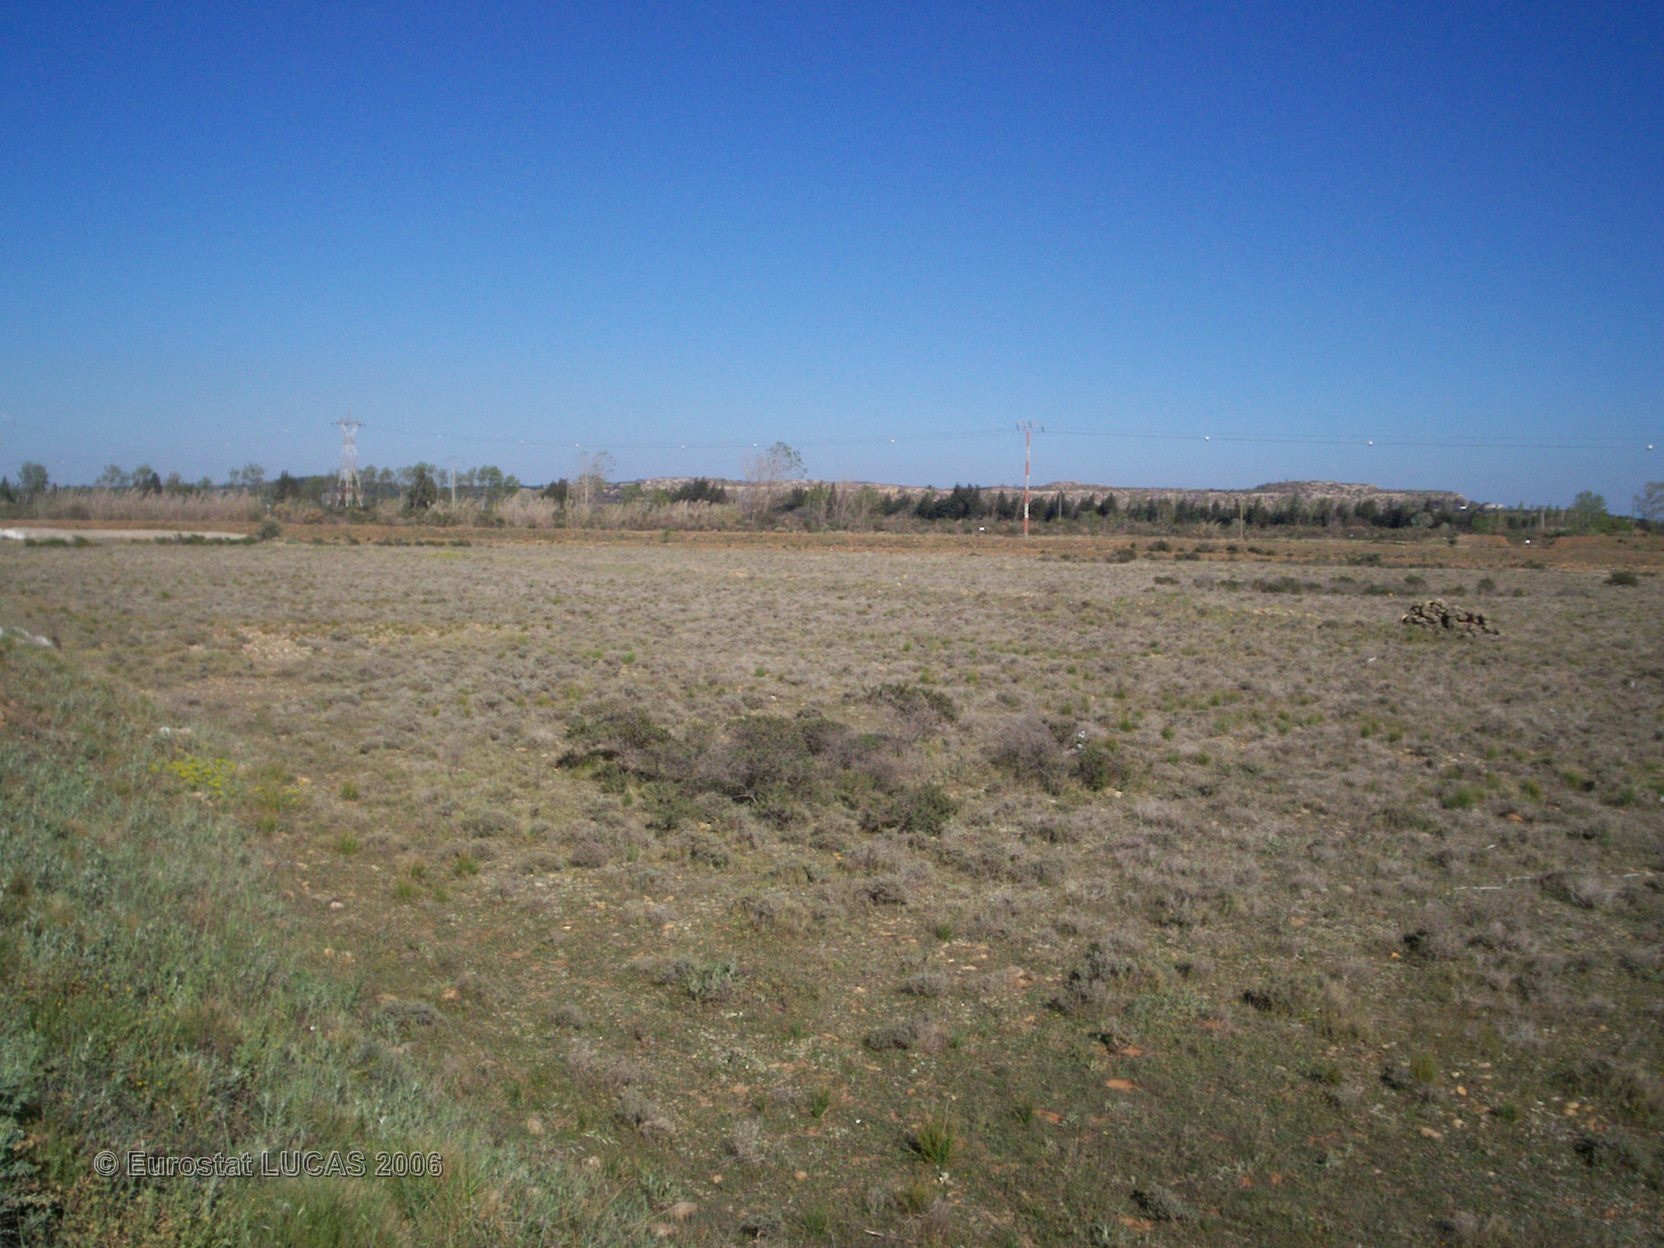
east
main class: Artificial land
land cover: Non built-up area features
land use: Logistics and storage
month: April
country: FR
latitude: 43.5408
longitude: 4.9481
